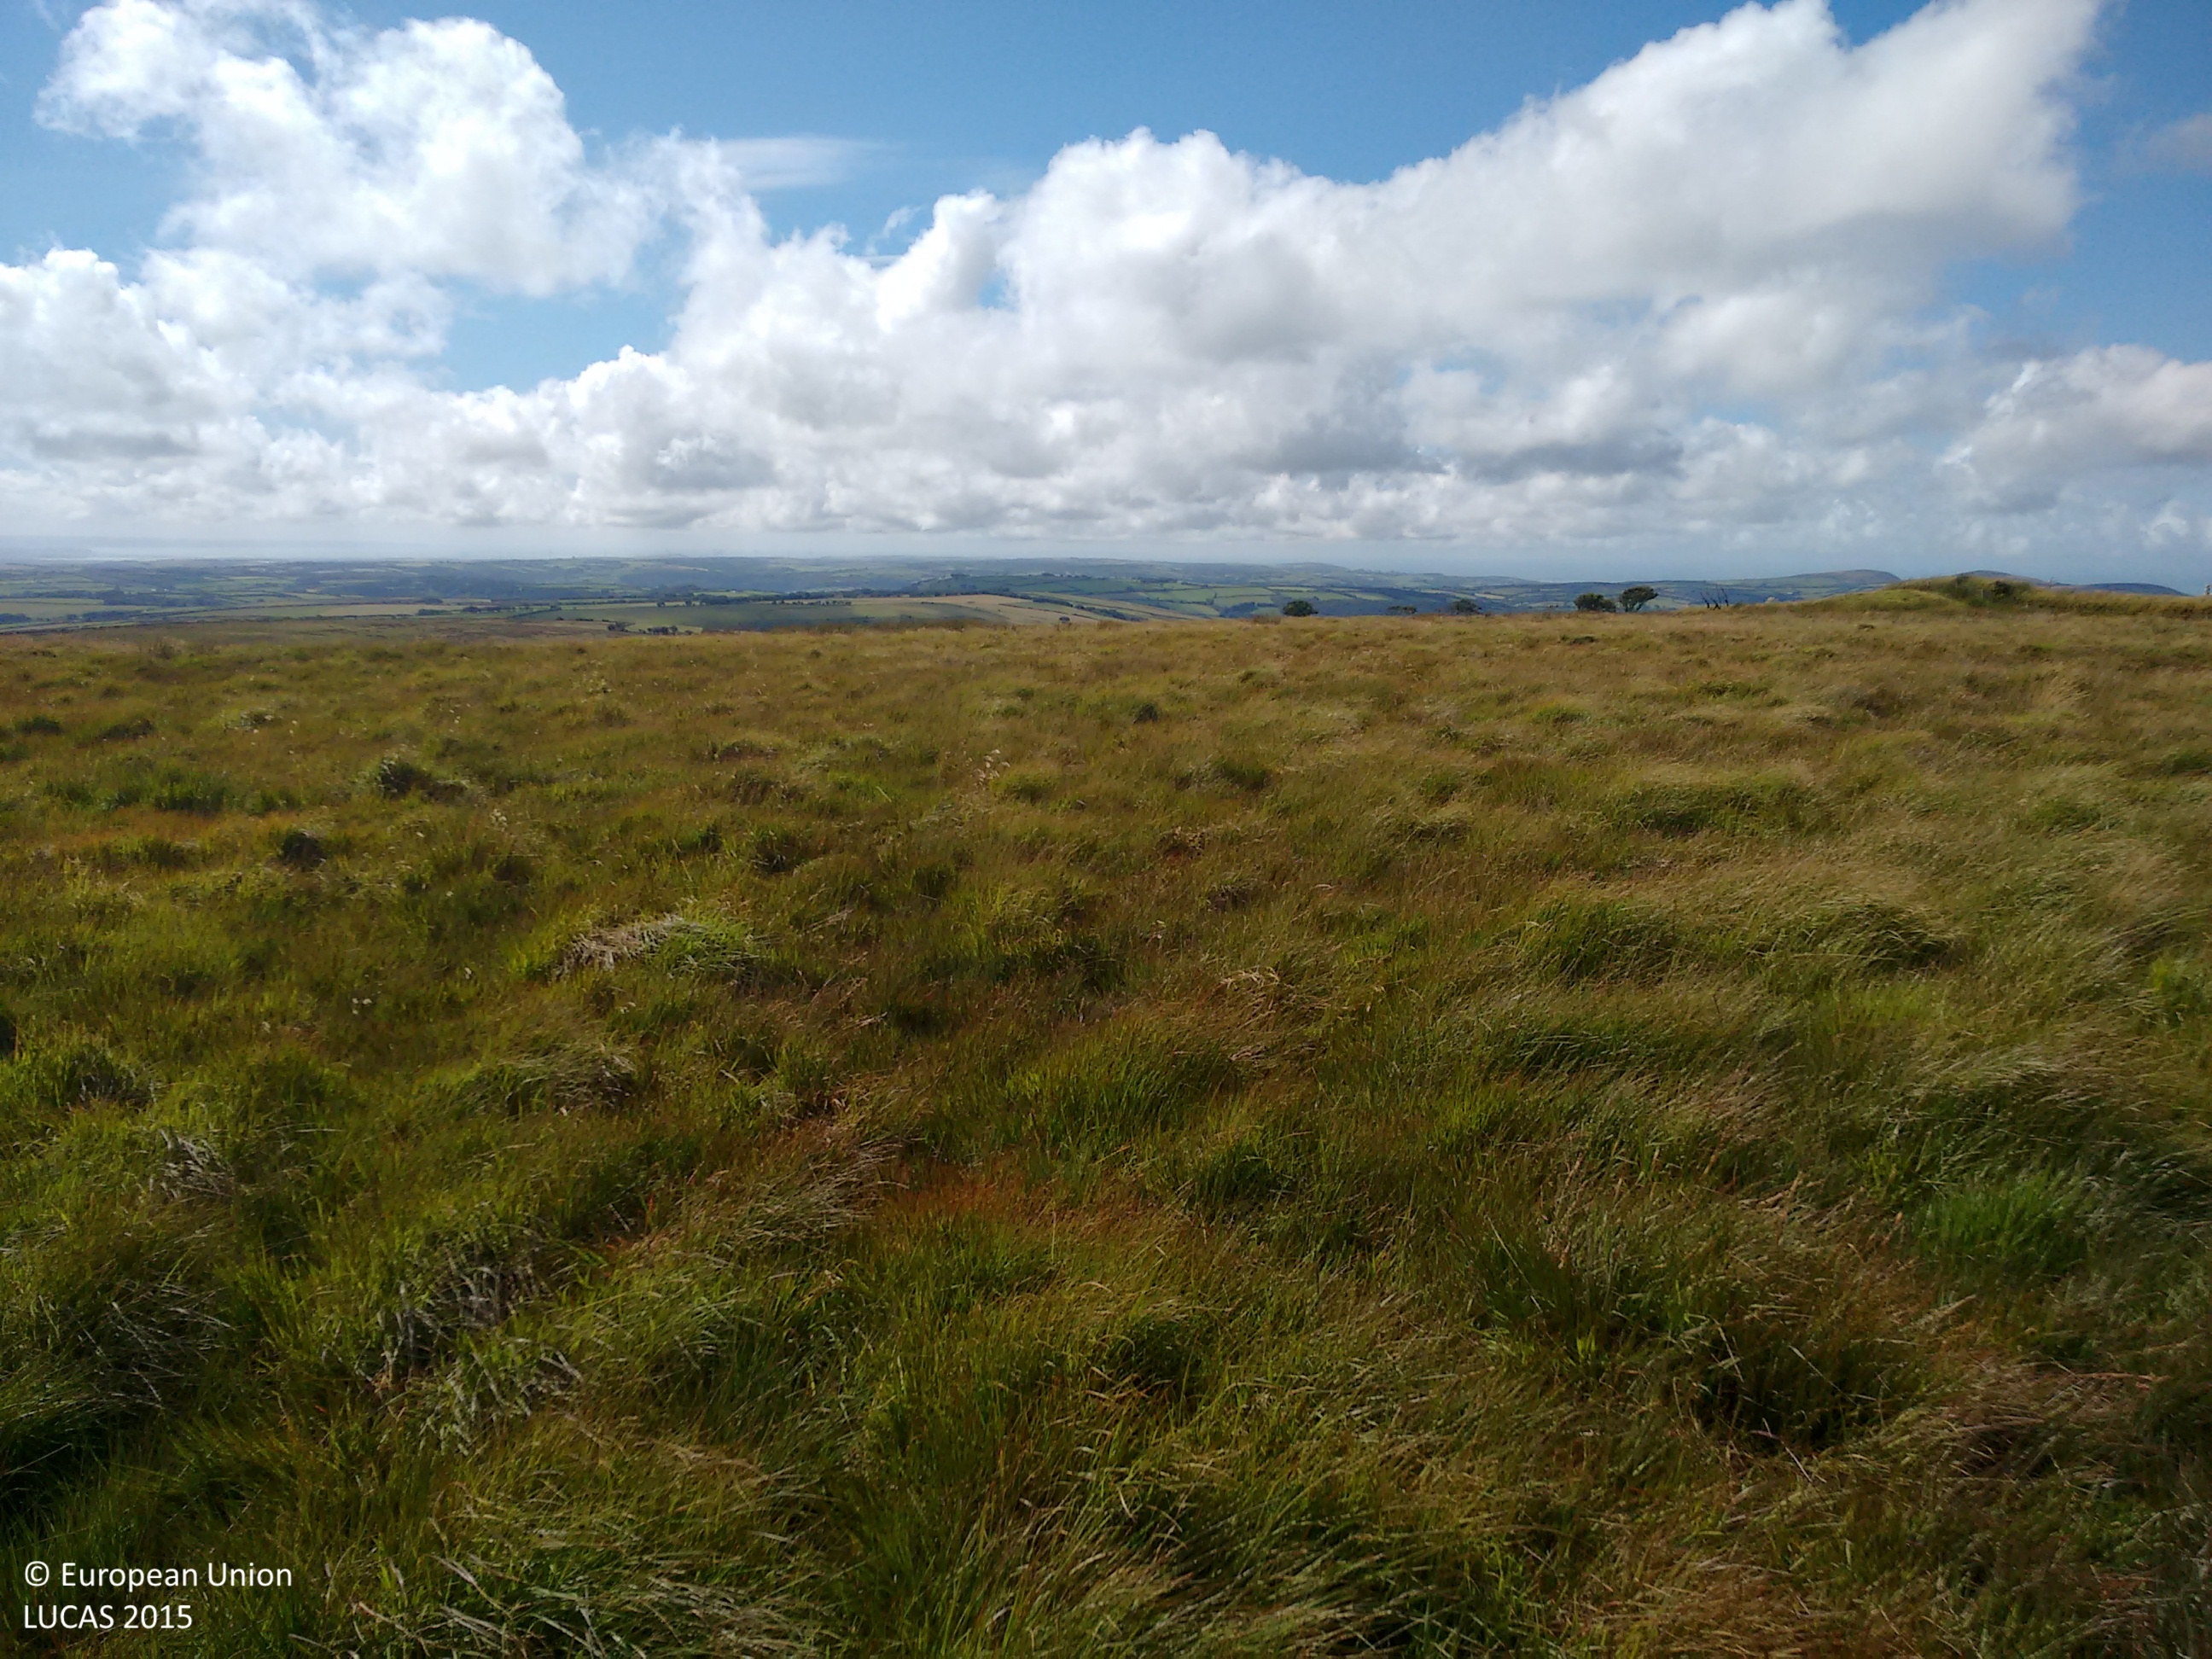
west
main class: Grassland
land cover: Grassland without tree/shrub cover
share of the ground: > 75 %
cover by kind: herbaceous plants 100 %
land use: Agriculture (excluding fallow land and kitchen gardens)
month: August
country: GB
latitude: 51.1751
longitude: -3.8661
